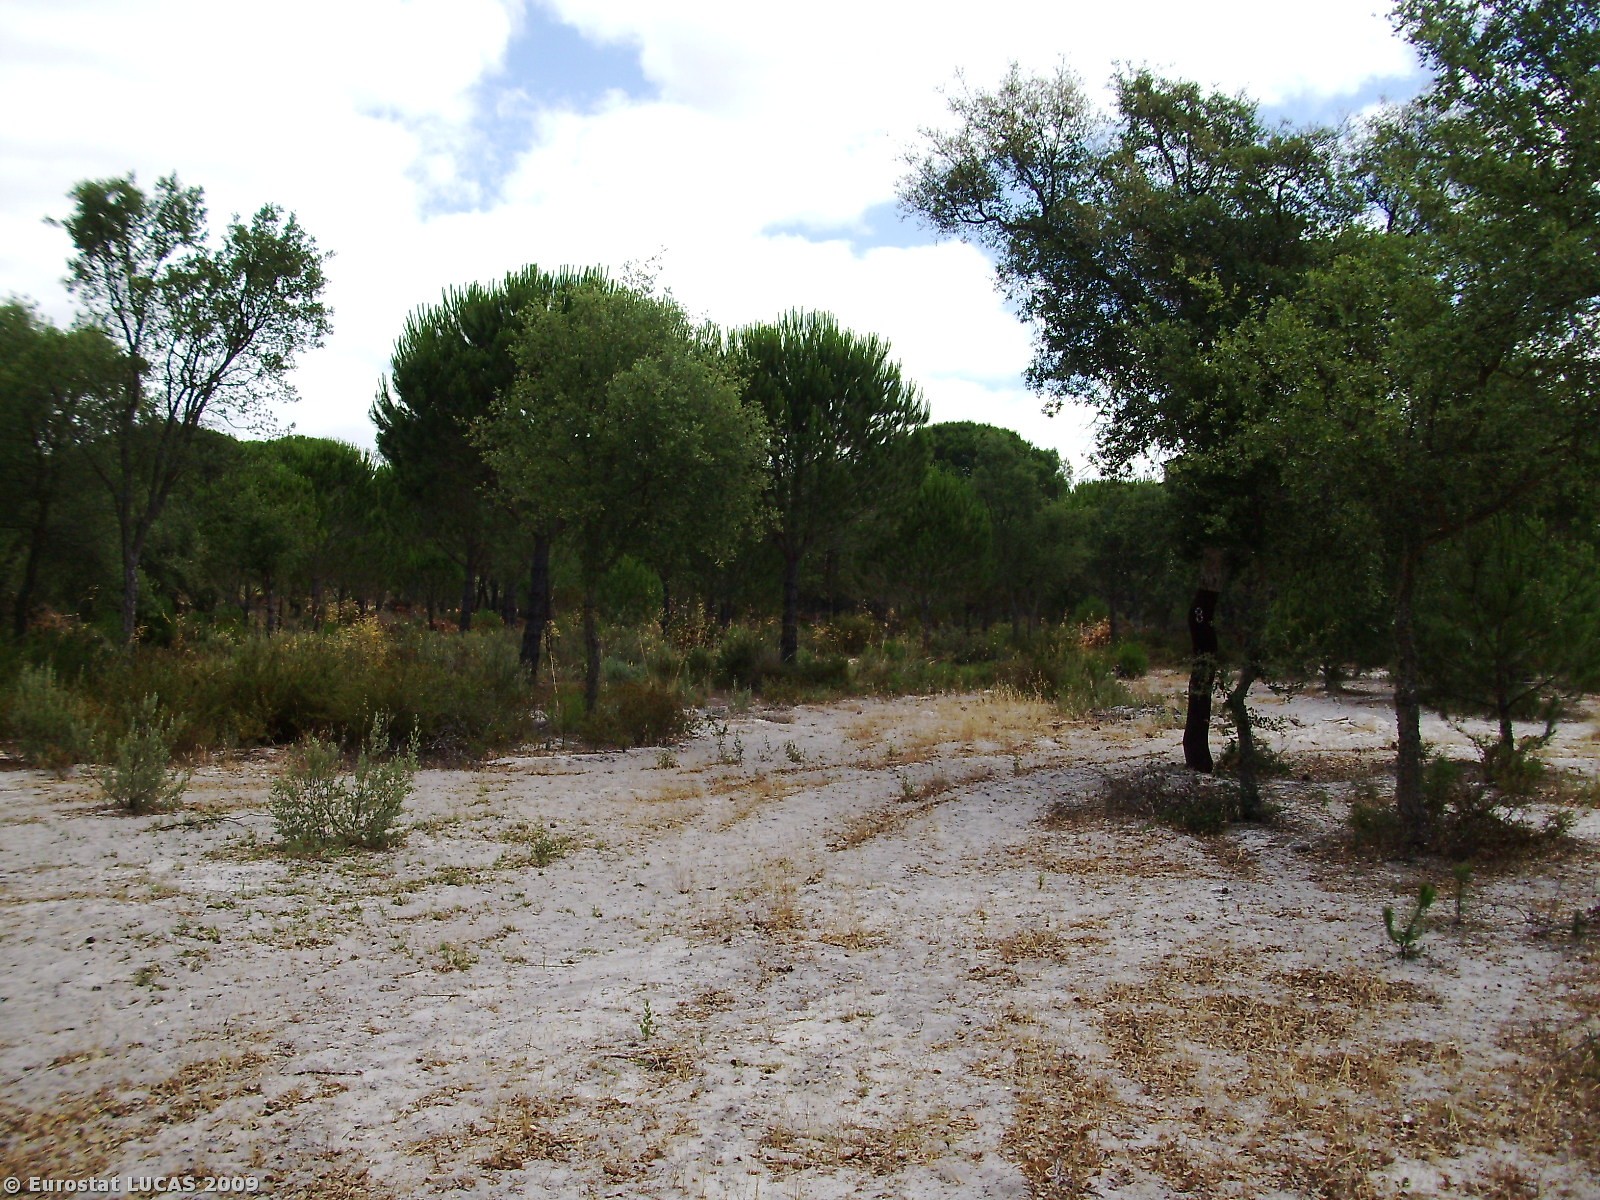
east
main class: Woodland
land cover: Broadleaved woodland
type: broadleaved evergreen forest
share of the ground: 25 - 50 %
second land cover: Spontaneously vegetated surfaces
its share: 10 - 25 %
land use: Forestry
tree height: > 5 m
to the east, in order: Broadleaved woodland; Spontaneously vegetated surfaces; Broadleaved woodland
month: June
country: PT
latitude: 38.2538
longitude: -8.5741
